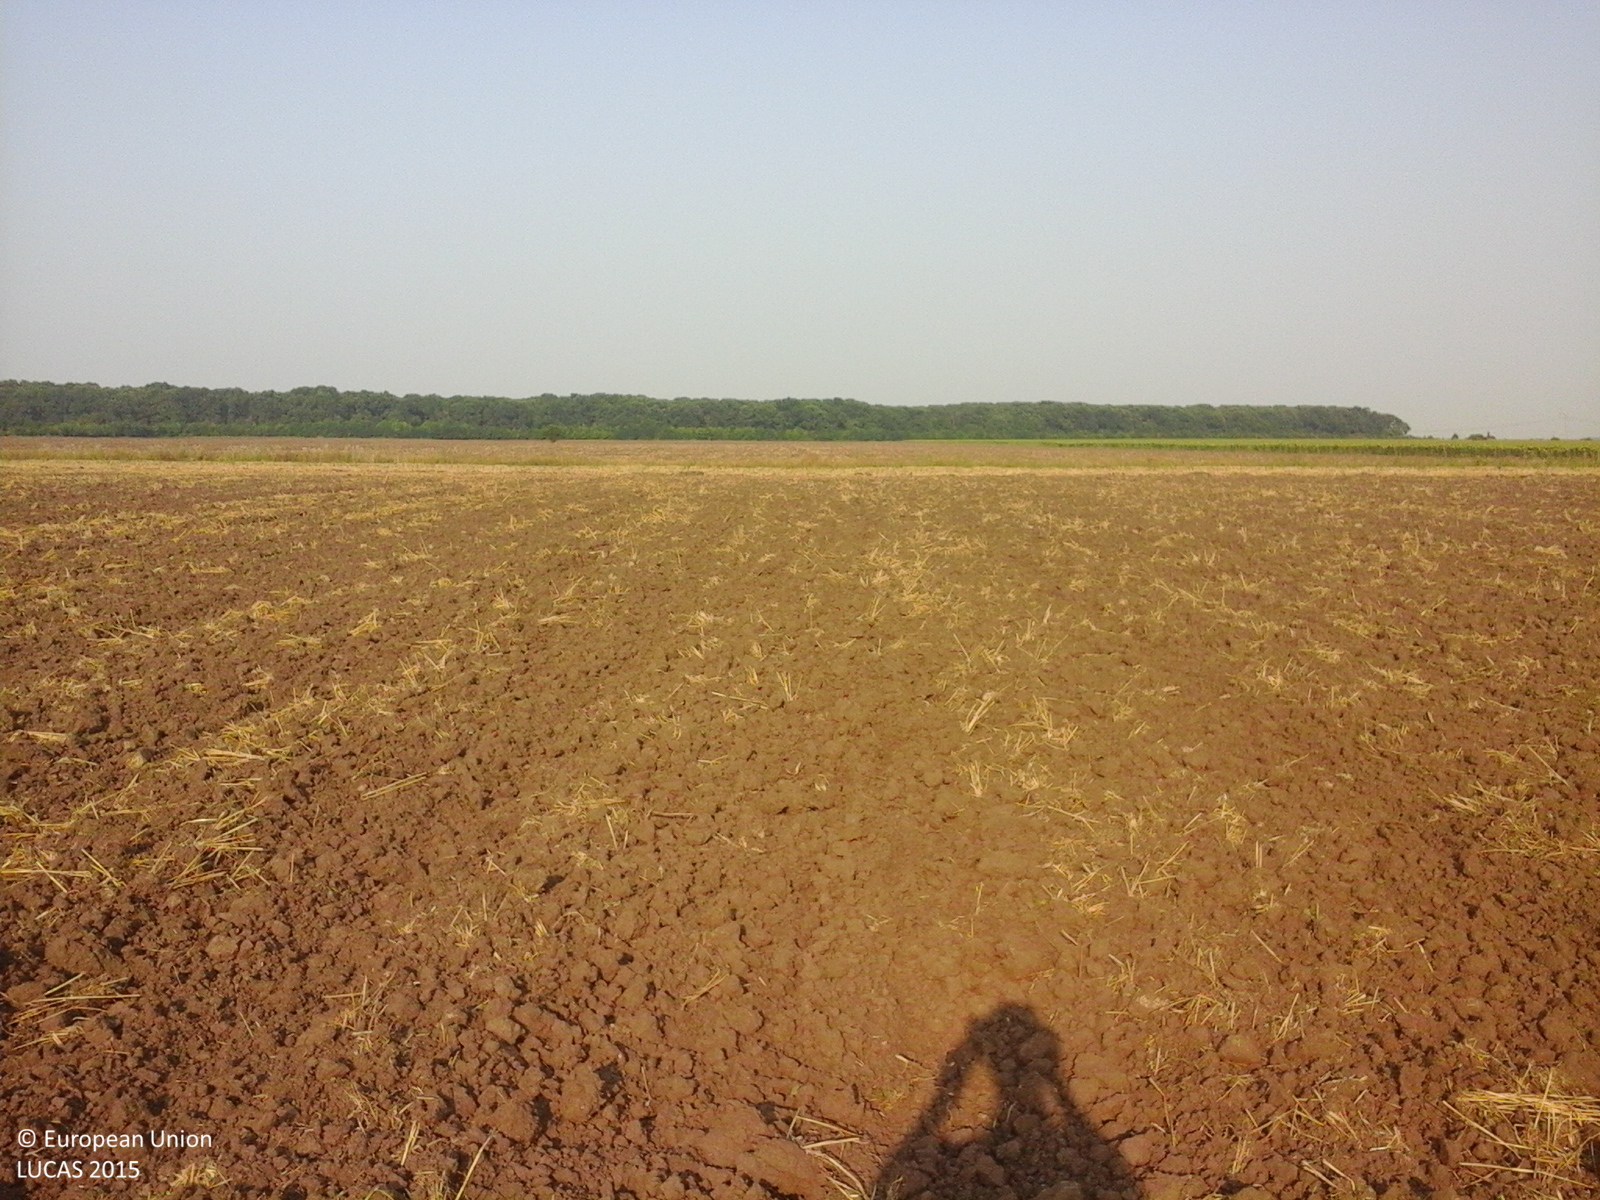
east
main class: Cropland
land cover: Common wheat
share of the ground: < 10 %
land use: Agriculture (excluding fallow land and kitchen gardens)
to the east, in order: Common wheat; Grass margins; Tracks; Grass margins; Common wheat
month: July
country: RO
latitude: 44.4481
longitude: 26.4108
